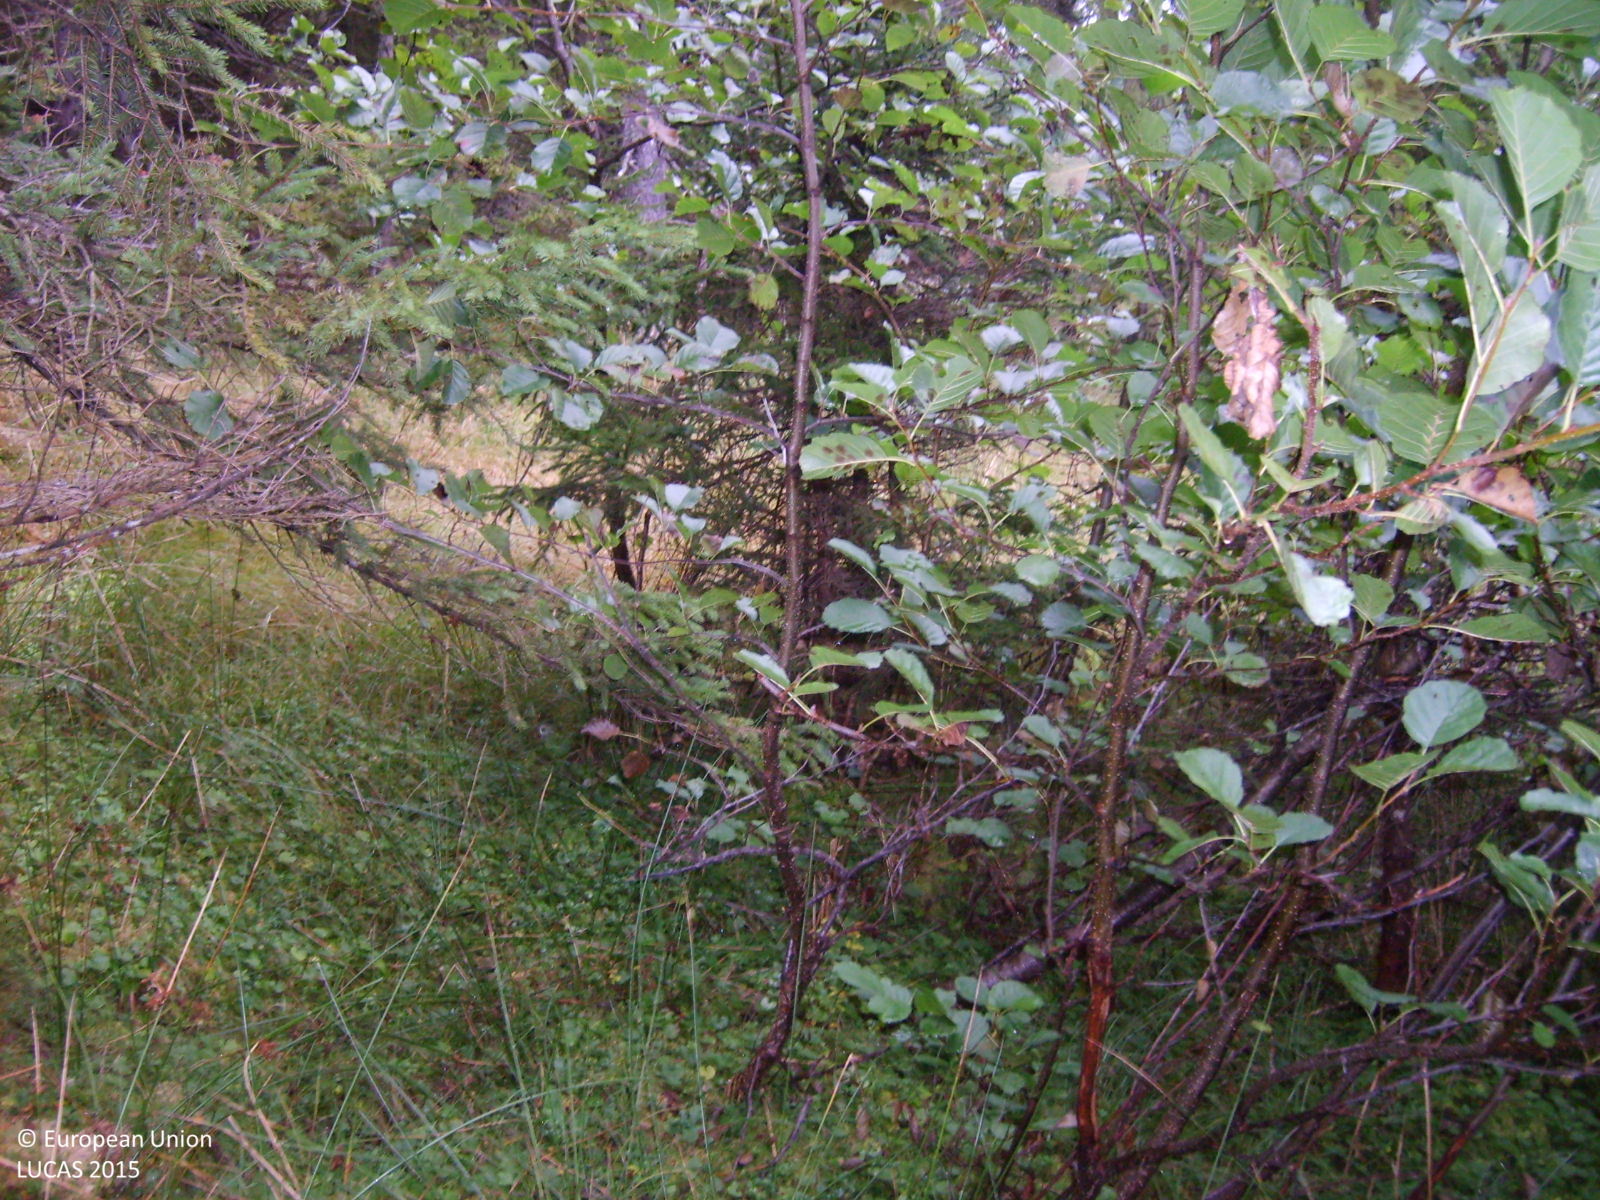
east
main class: Woodland
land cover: Spruce dominated coniferous woodland
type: alpine coniferous forest
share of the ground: > 75 %
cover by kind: coniferous forest trees 70 %, broadleaved forest trees 10 %, shrubs 10 %, herbaceous plants 10 %
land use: Forestry
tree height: > 5 m
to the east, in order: Spruce dominated coniferous woodland; Tracks; Grassland without tree/shrub cover; Inland marshes; Grassland without tree/shrub cover; Artificial constructions in urban areas; Grassland without tree/shrub cover; Spruce dominated coniferous woodland
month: September
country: AT
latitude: 47.4847
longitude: 13.4622
